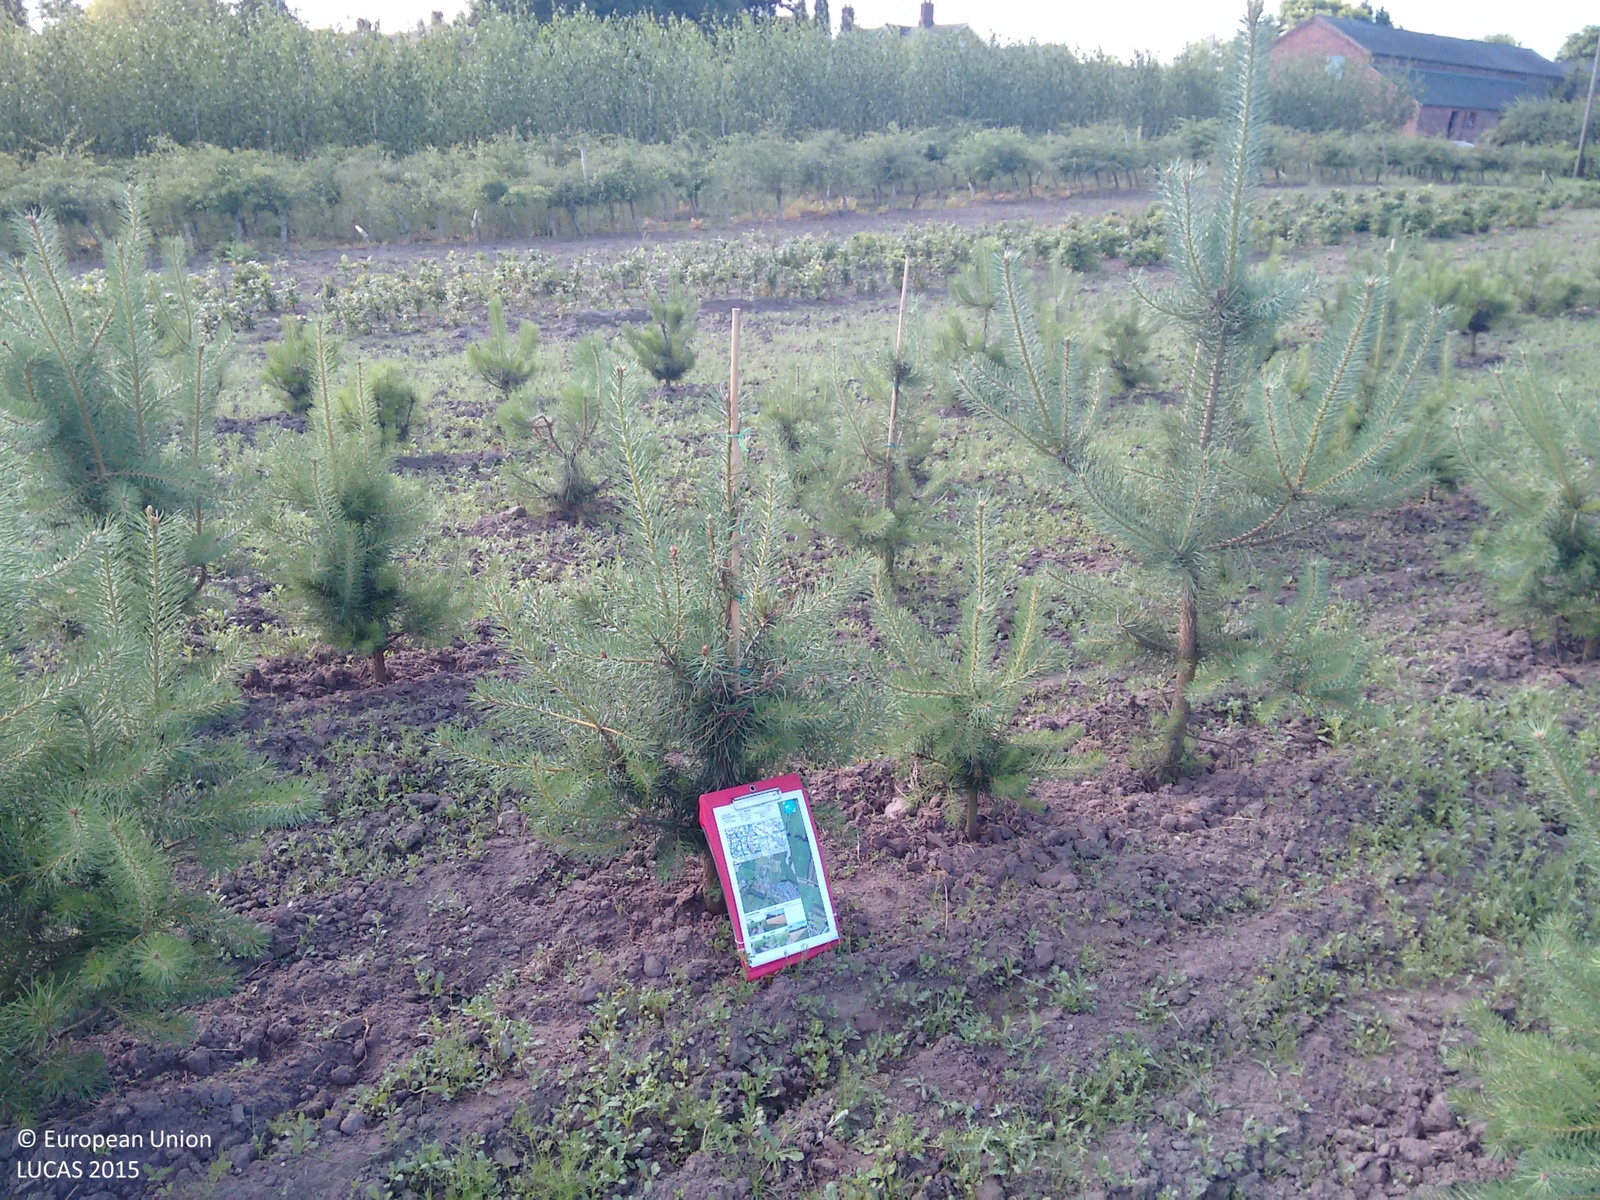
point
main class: Cropland
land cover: Nurseries
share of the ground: > 75 %
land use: Agriculture (excluding fallow land and kitchen gardens)
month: July
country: GB
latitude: 53.1177
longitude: -2.2995
